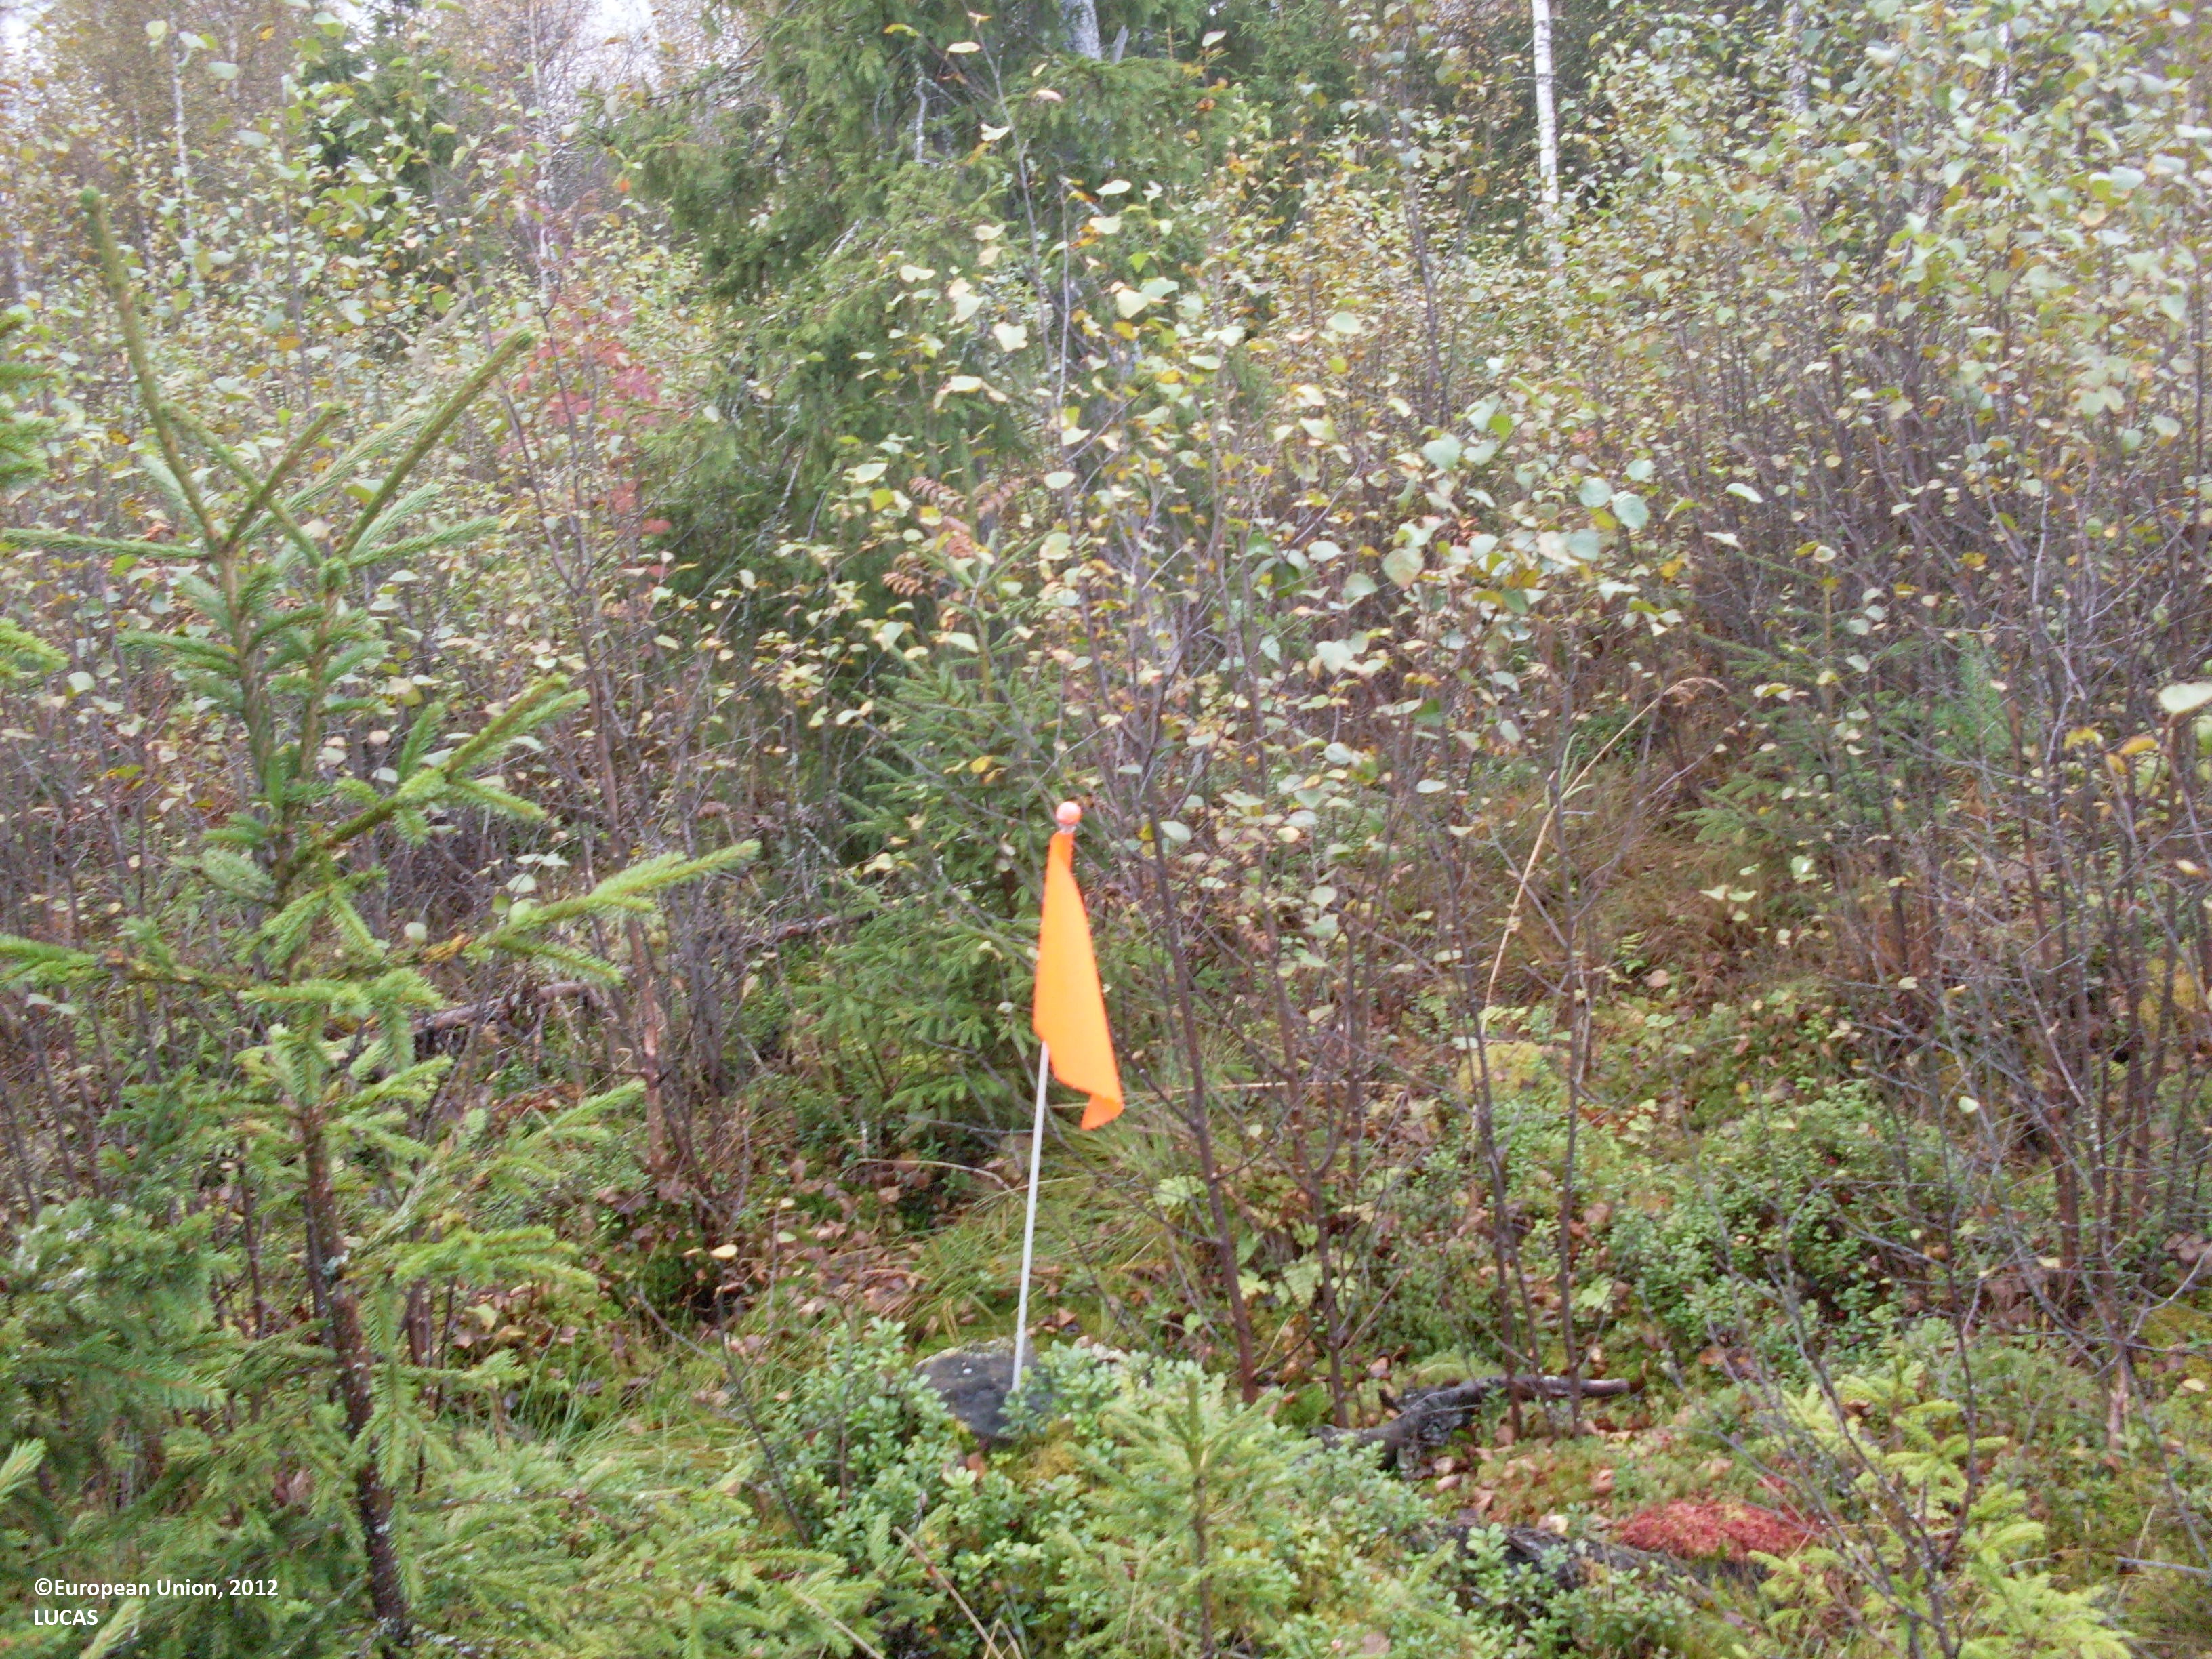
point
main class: Shrubland
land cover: Shrubland with sparse tree cover
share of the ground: > 75 %
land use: Forestry
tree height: < 5 m
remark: Clear cut
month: September
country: FI
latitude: 64.1753
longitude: 28.4704
